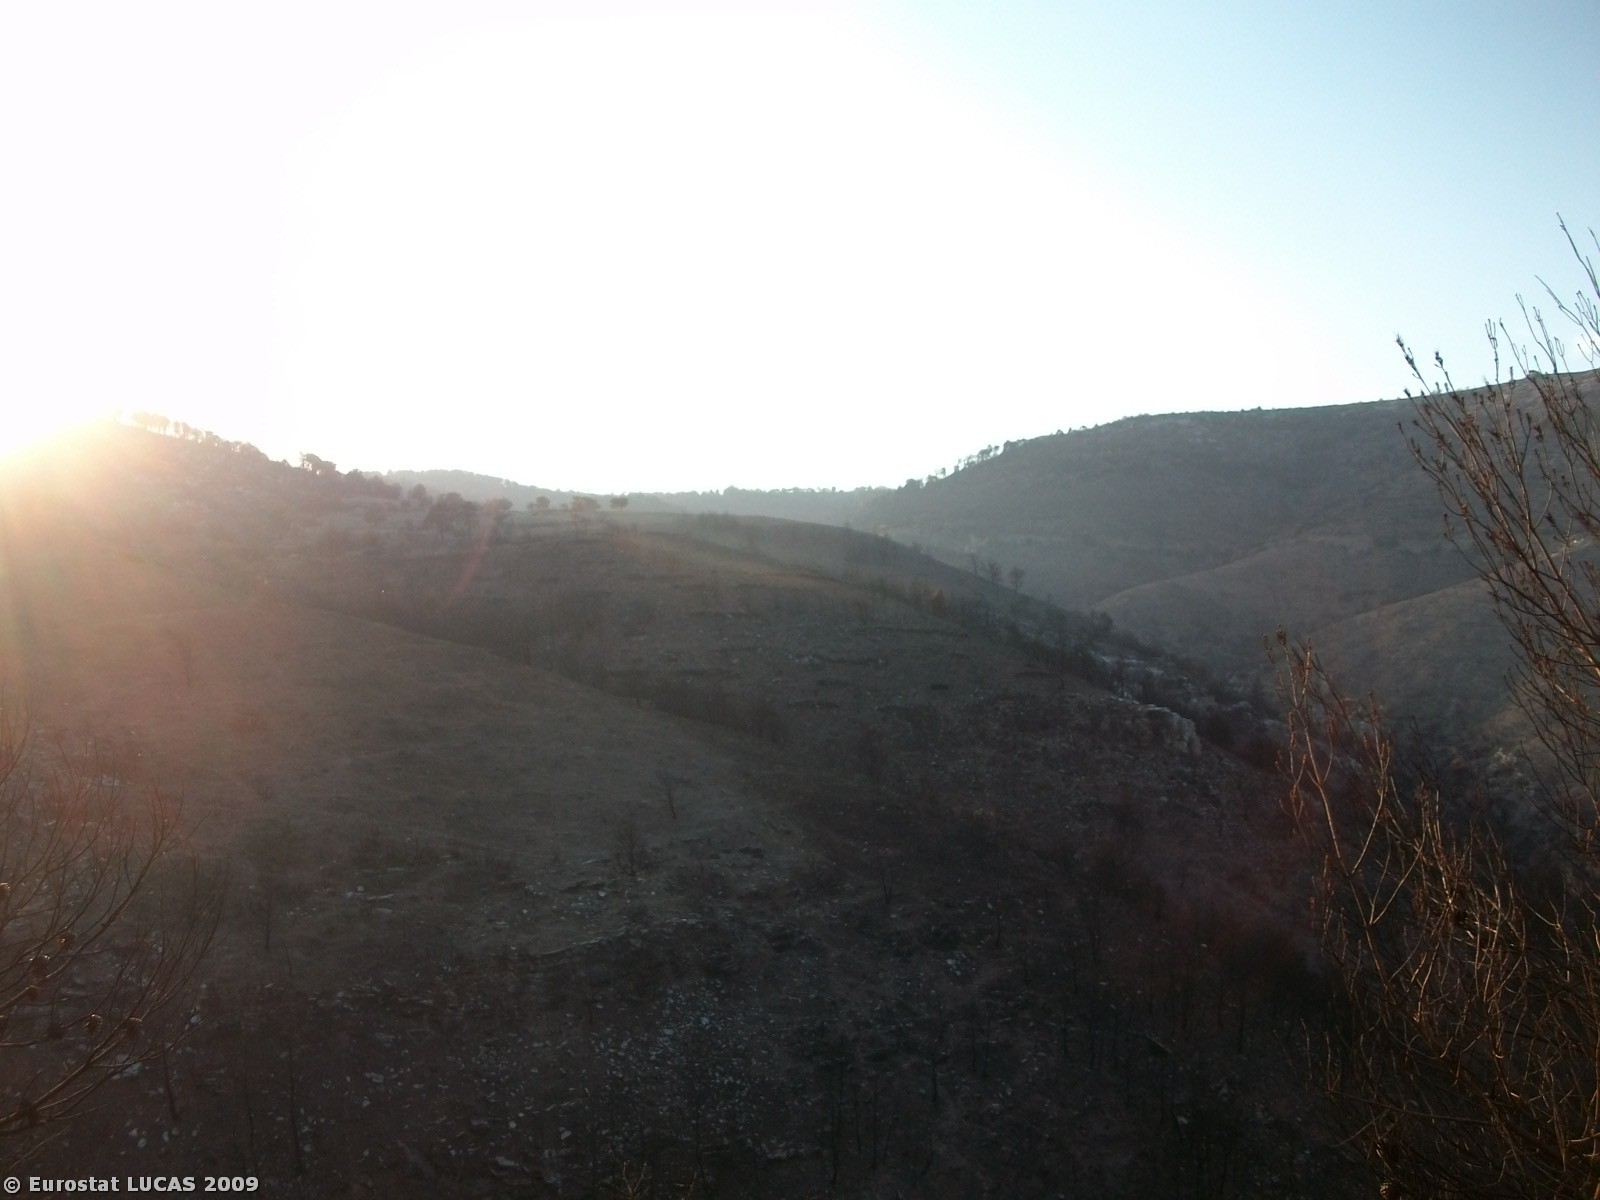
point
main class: Grassland
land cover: Grassland with sparse tree/shrub cover
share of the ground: > 75 %
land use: Unused
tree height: > 5 m
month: September
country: GR
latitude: 38.2367
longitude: 23.9594
